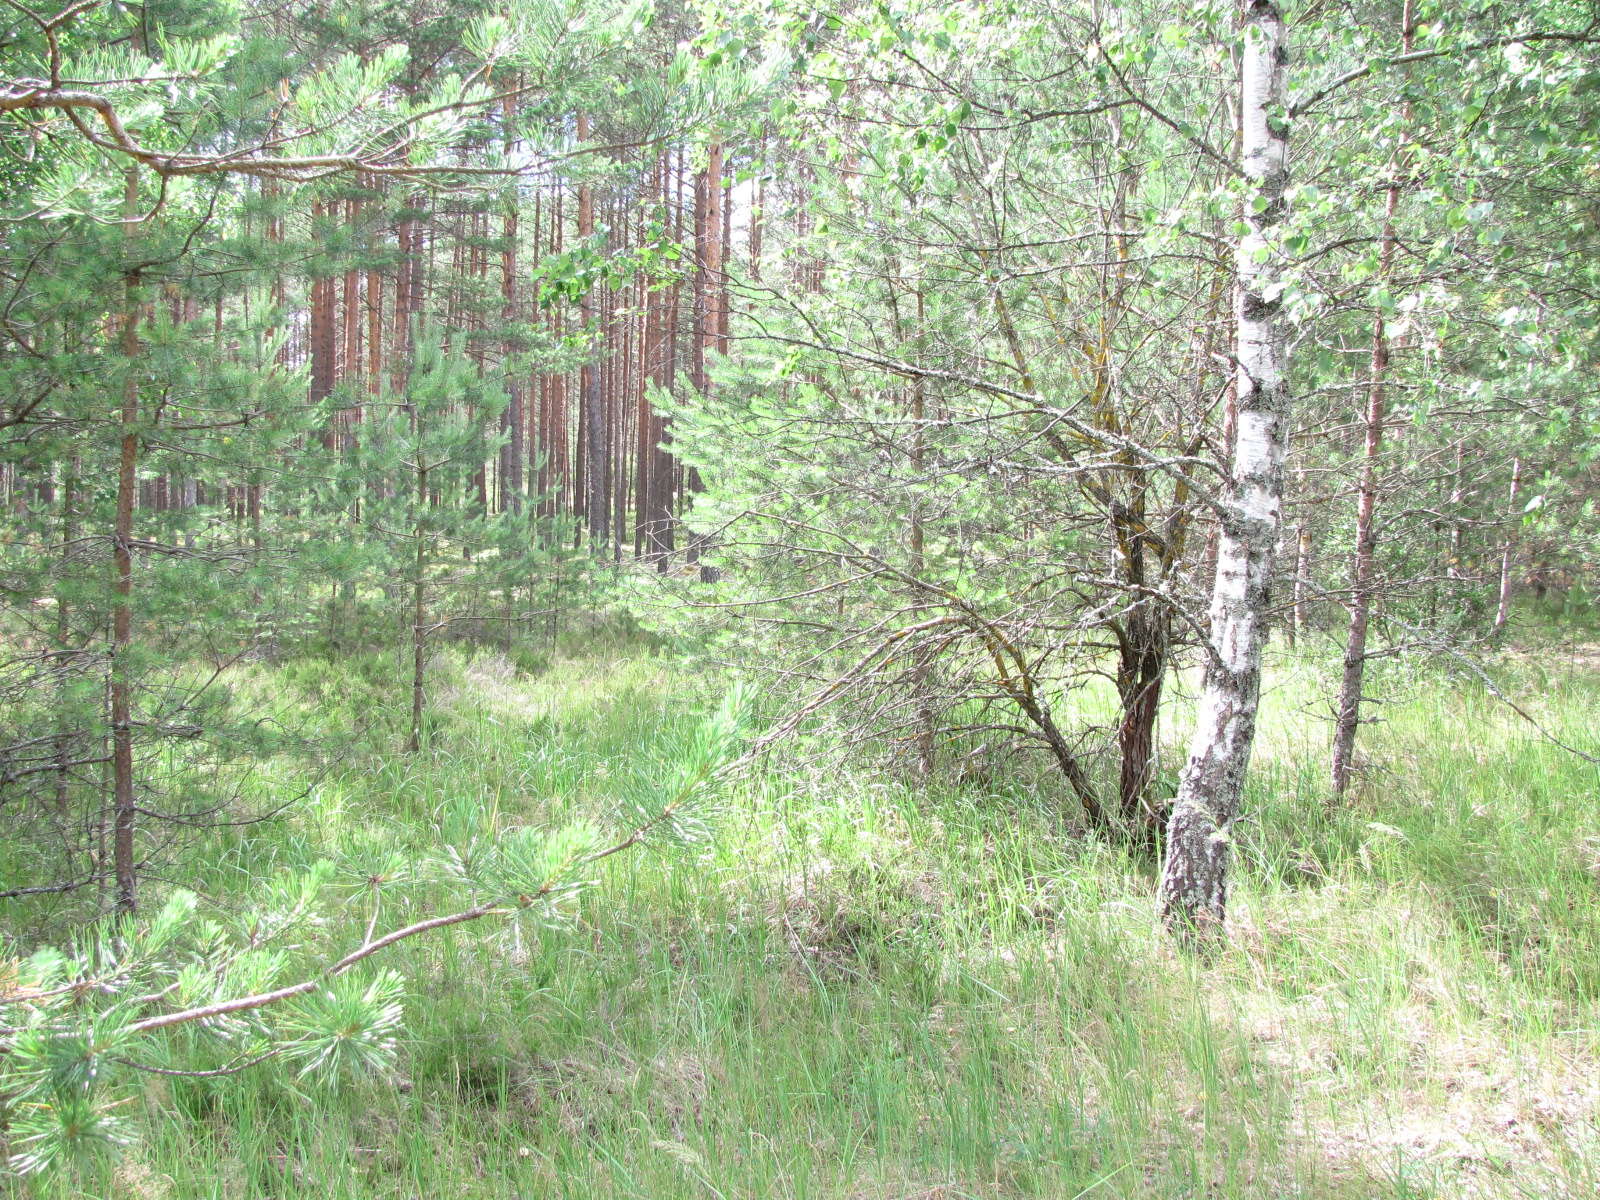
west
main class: Woodland
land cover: Pine dominated coniferous woodland
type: hemiboreal forest and nemoral coniferous forest and mixed broadleaved-coniferous forest
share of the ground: 50 - 75 %
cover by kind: coniferous forest trees 70 %, herbaceous plants 25 %, lichens and mosses 5 %
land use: Forestry
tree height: > 5 m
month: July
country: LV
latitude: 57.0304
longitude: 24.4429
